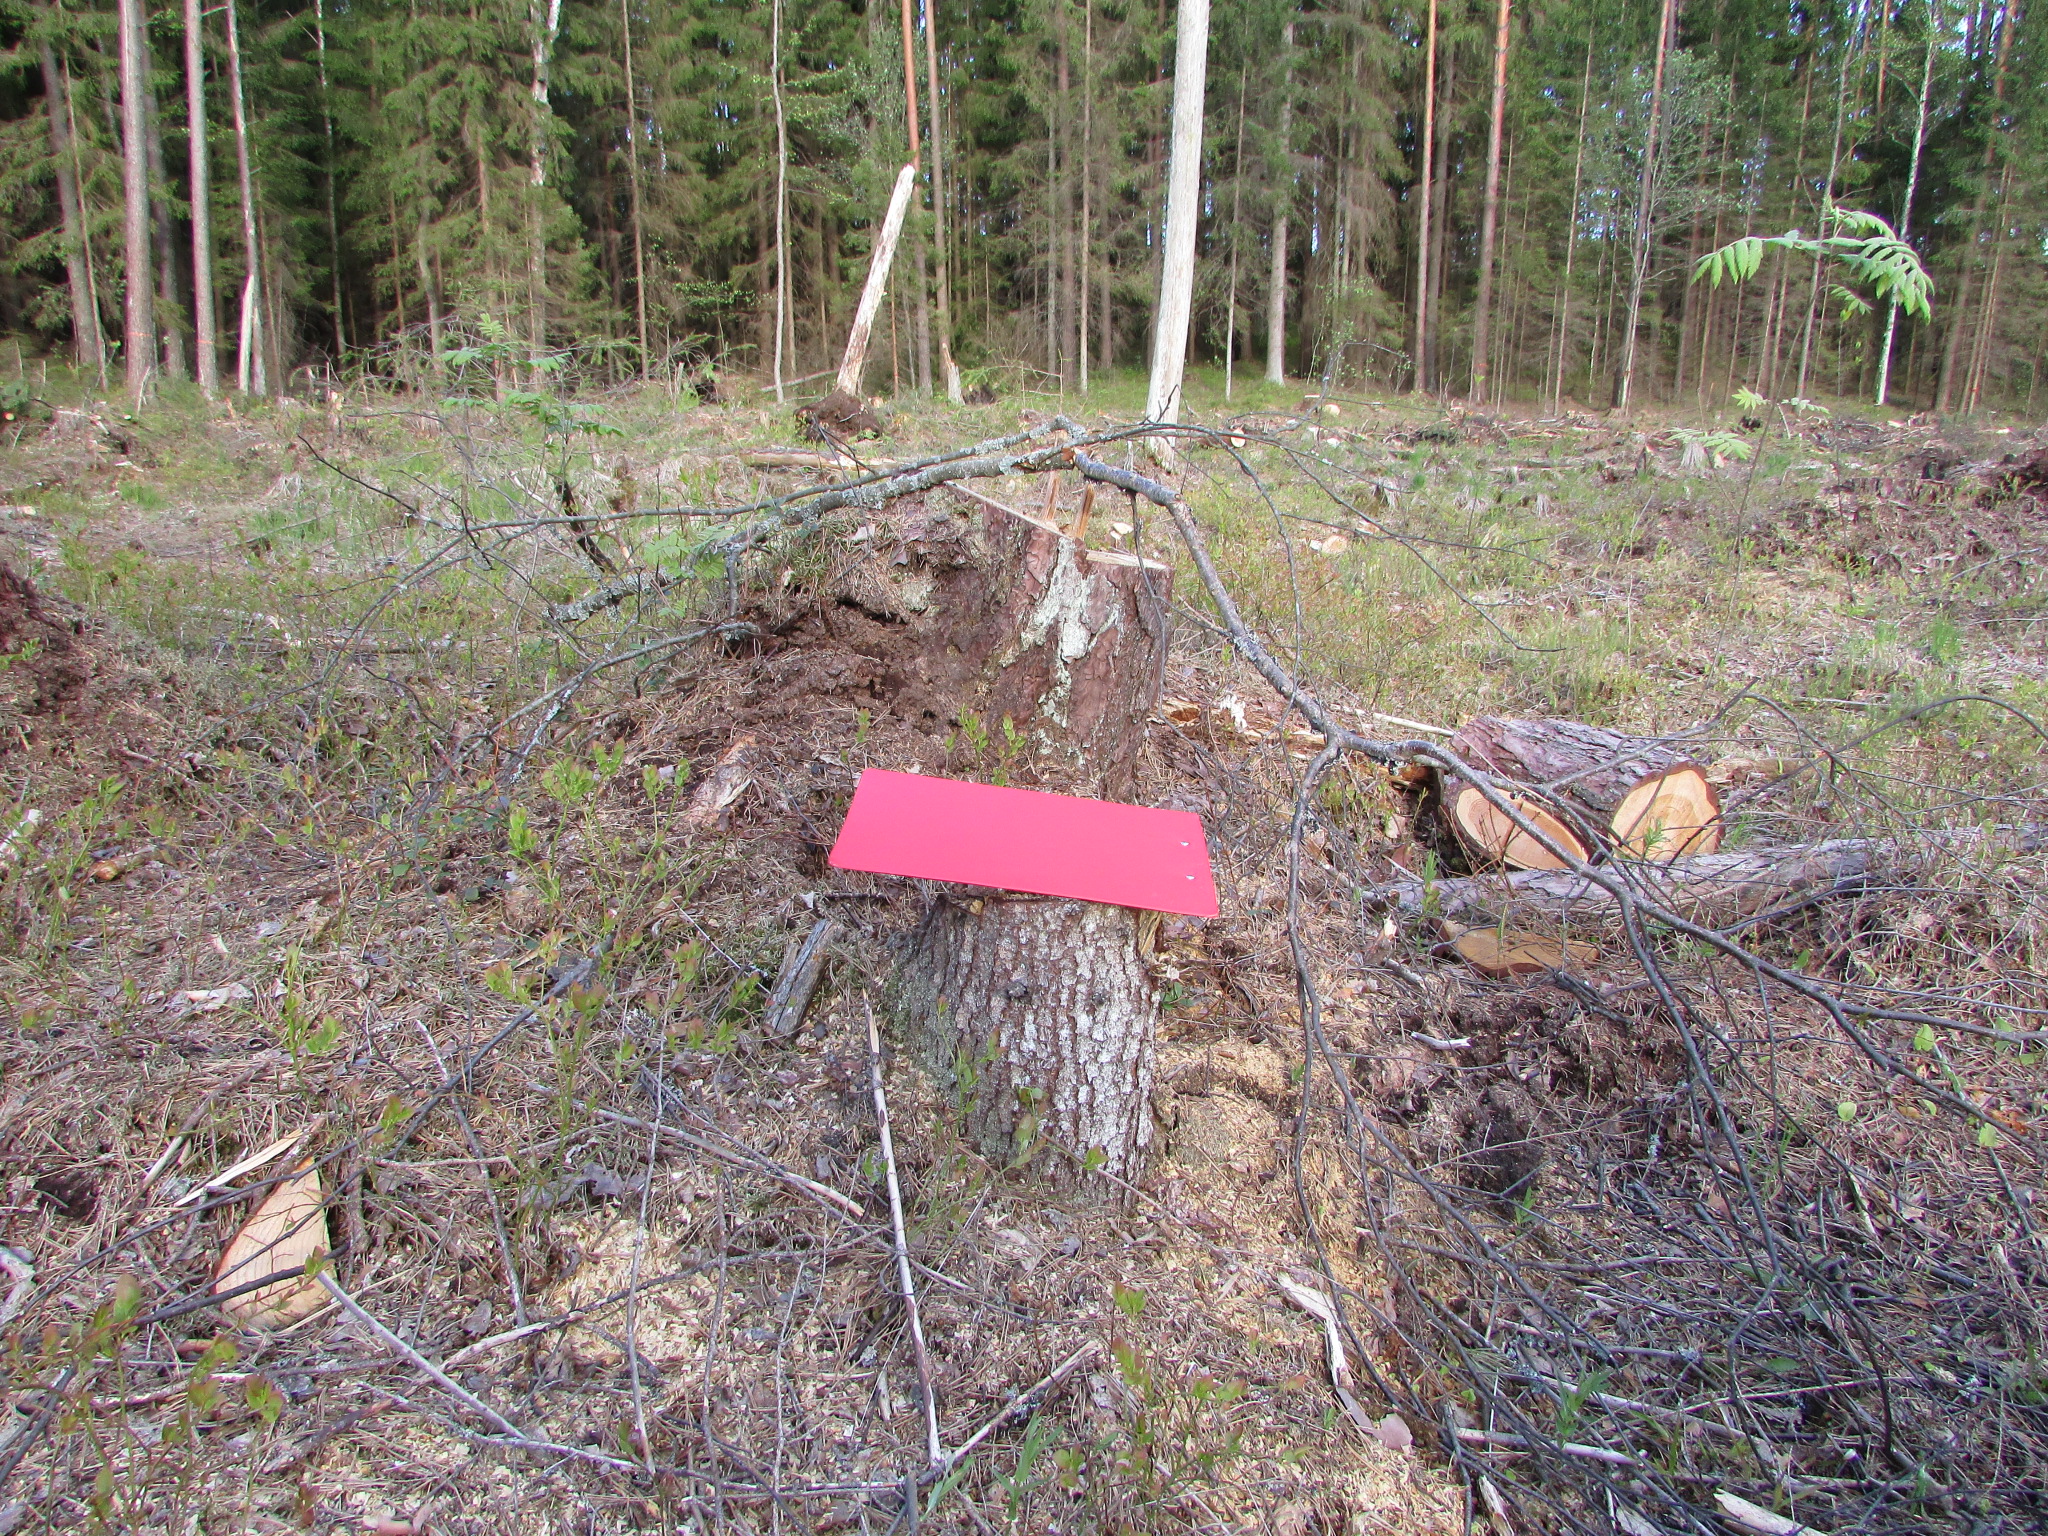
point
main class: Grassland
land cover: Spontaneously vegetated surfaces
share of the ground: 25 - 50 %
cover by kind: unconsolidated bare surface 60 %, herbaceous plants 30 %
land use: Forestry
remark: Clear cut
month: May
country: LV
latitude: 56.1618
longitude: 27.1575
